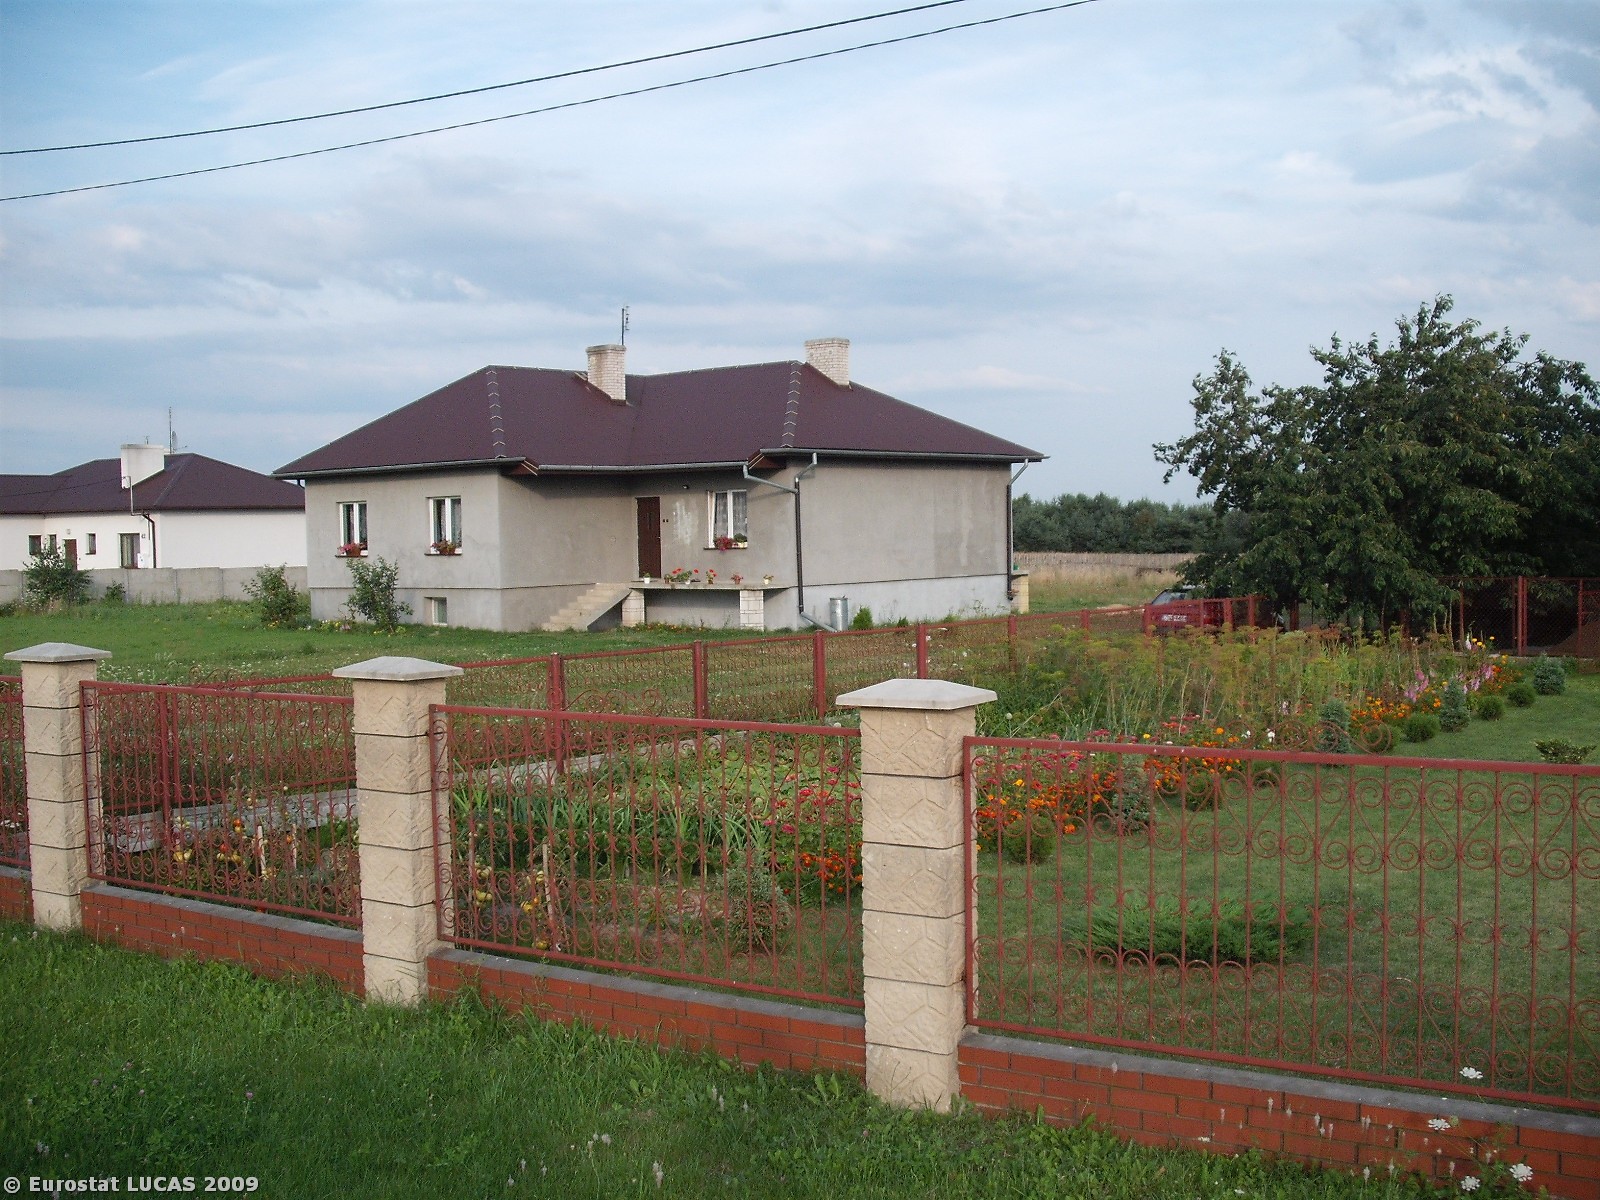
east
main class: Grassland
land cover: Grassland without tree/shrub cover
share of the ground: > 75 %
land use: Residential
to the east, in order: Grassland without tree/shrub cover; Artificial constructions in urban areas; Rye; Coniferous woodland
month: July
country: PL
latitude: 50.6263
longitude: 21.2288
